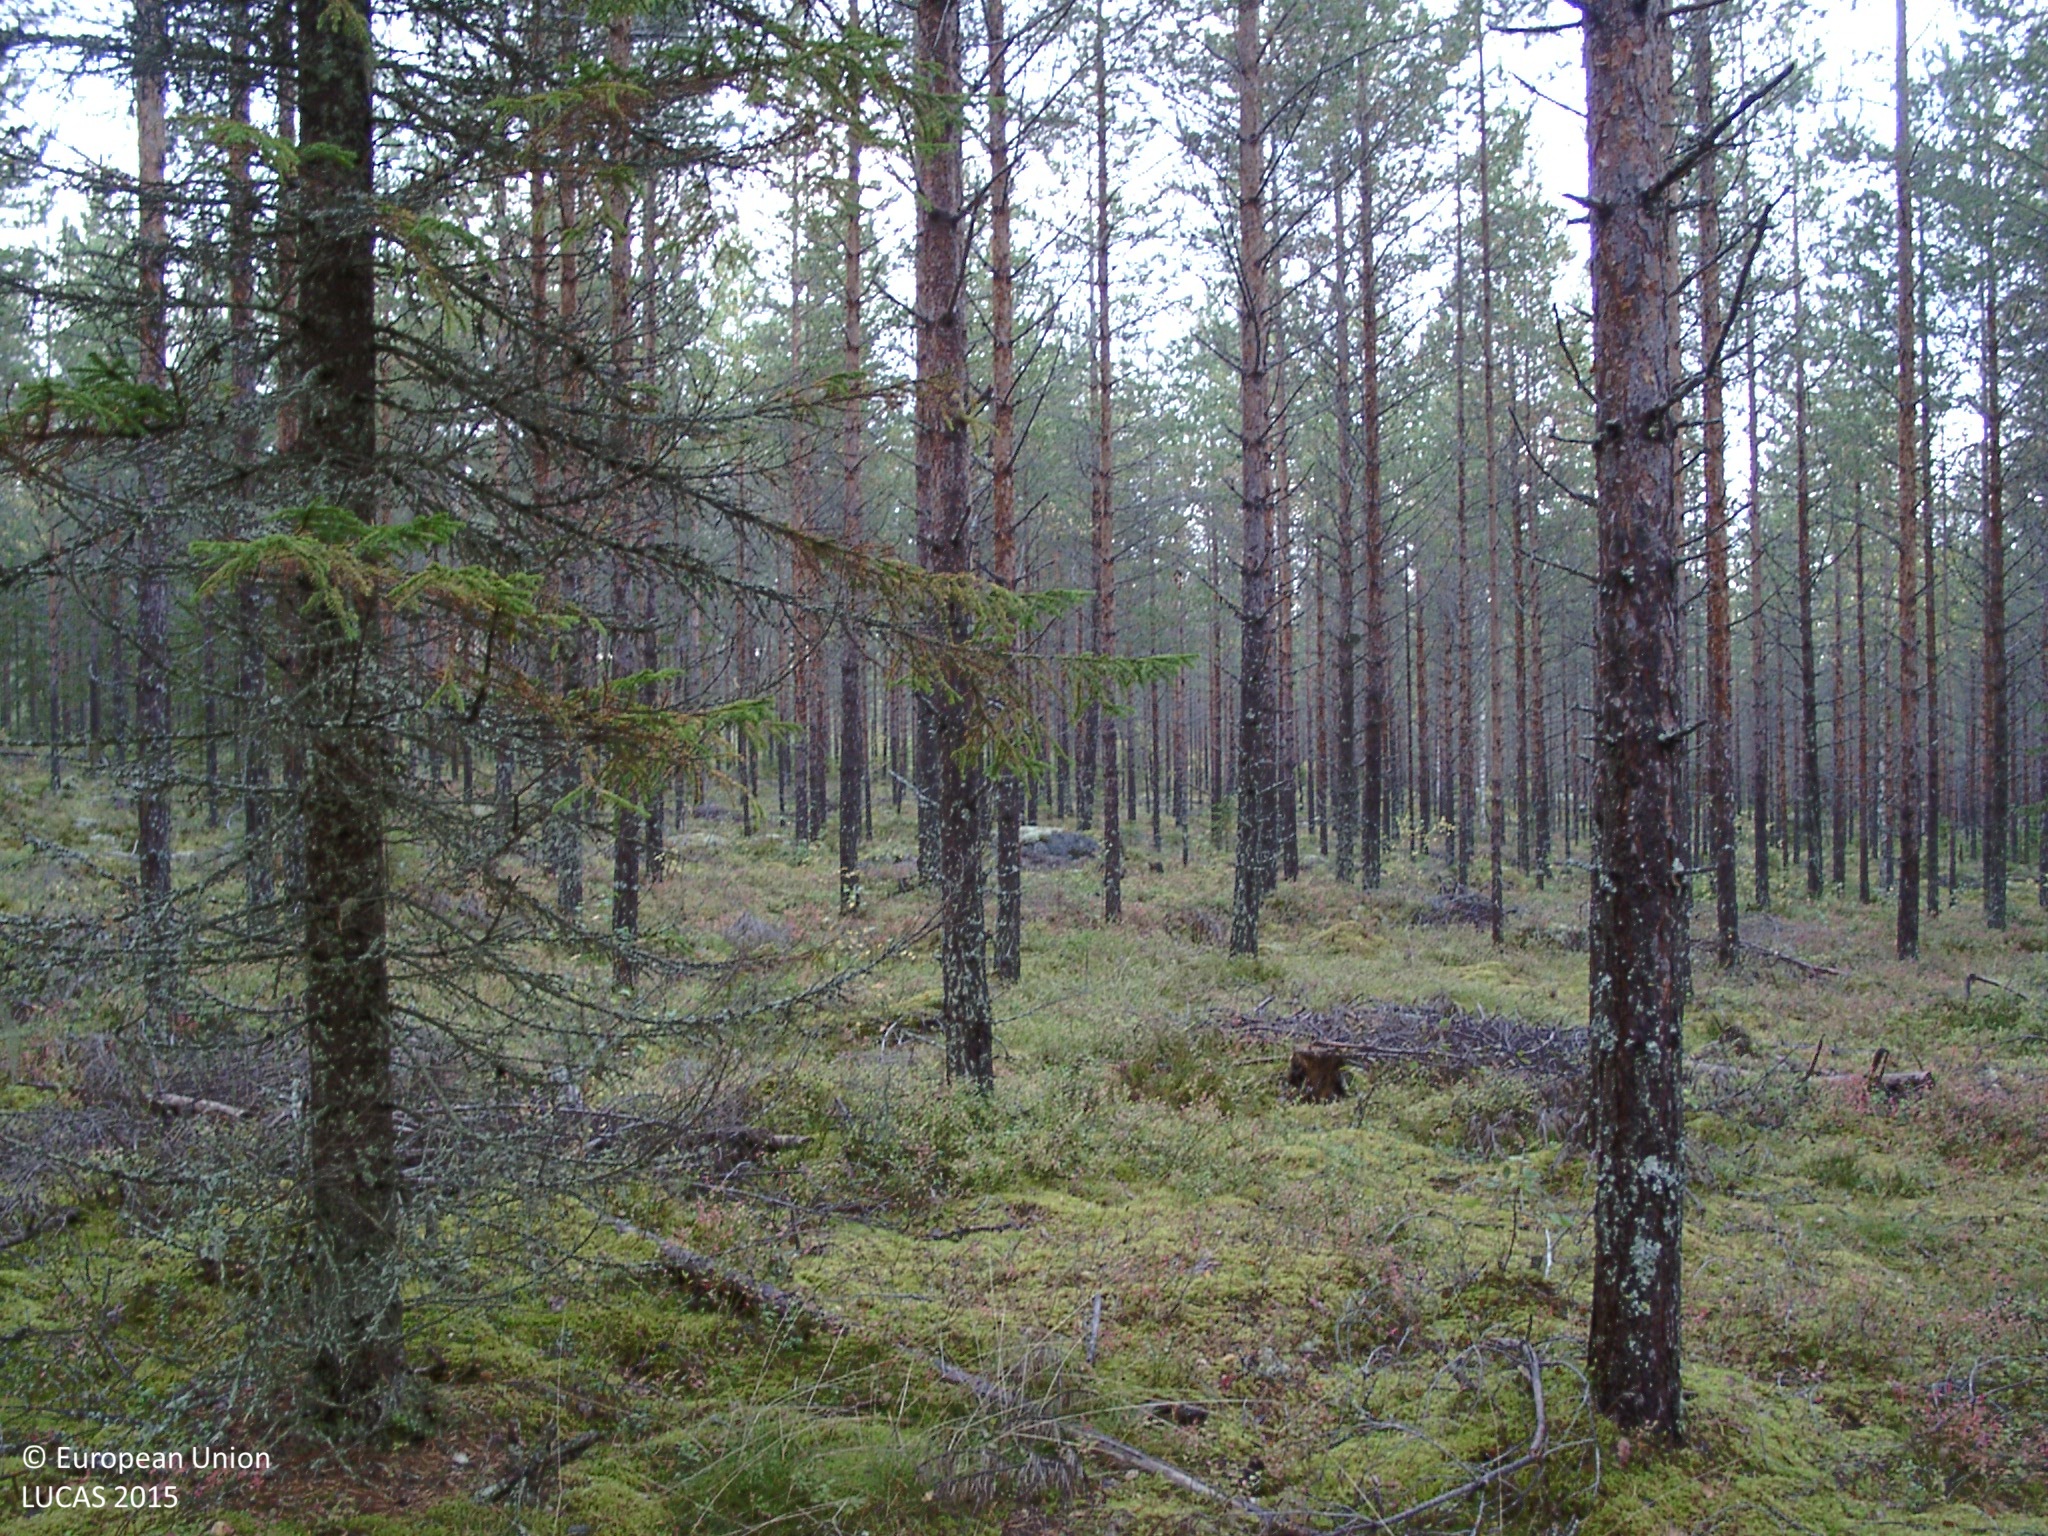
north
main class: Woodland
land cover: Pine dominated coniferous woodland
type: boreal forest
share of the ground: 50 - 75 %
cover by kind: coniferous forest trees 65 %, lichens and mosses 20 %, shrubs 15 %
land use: Forestry
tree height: > 5 m
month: September
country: FI
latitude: 62.7380
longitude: 25.5502
